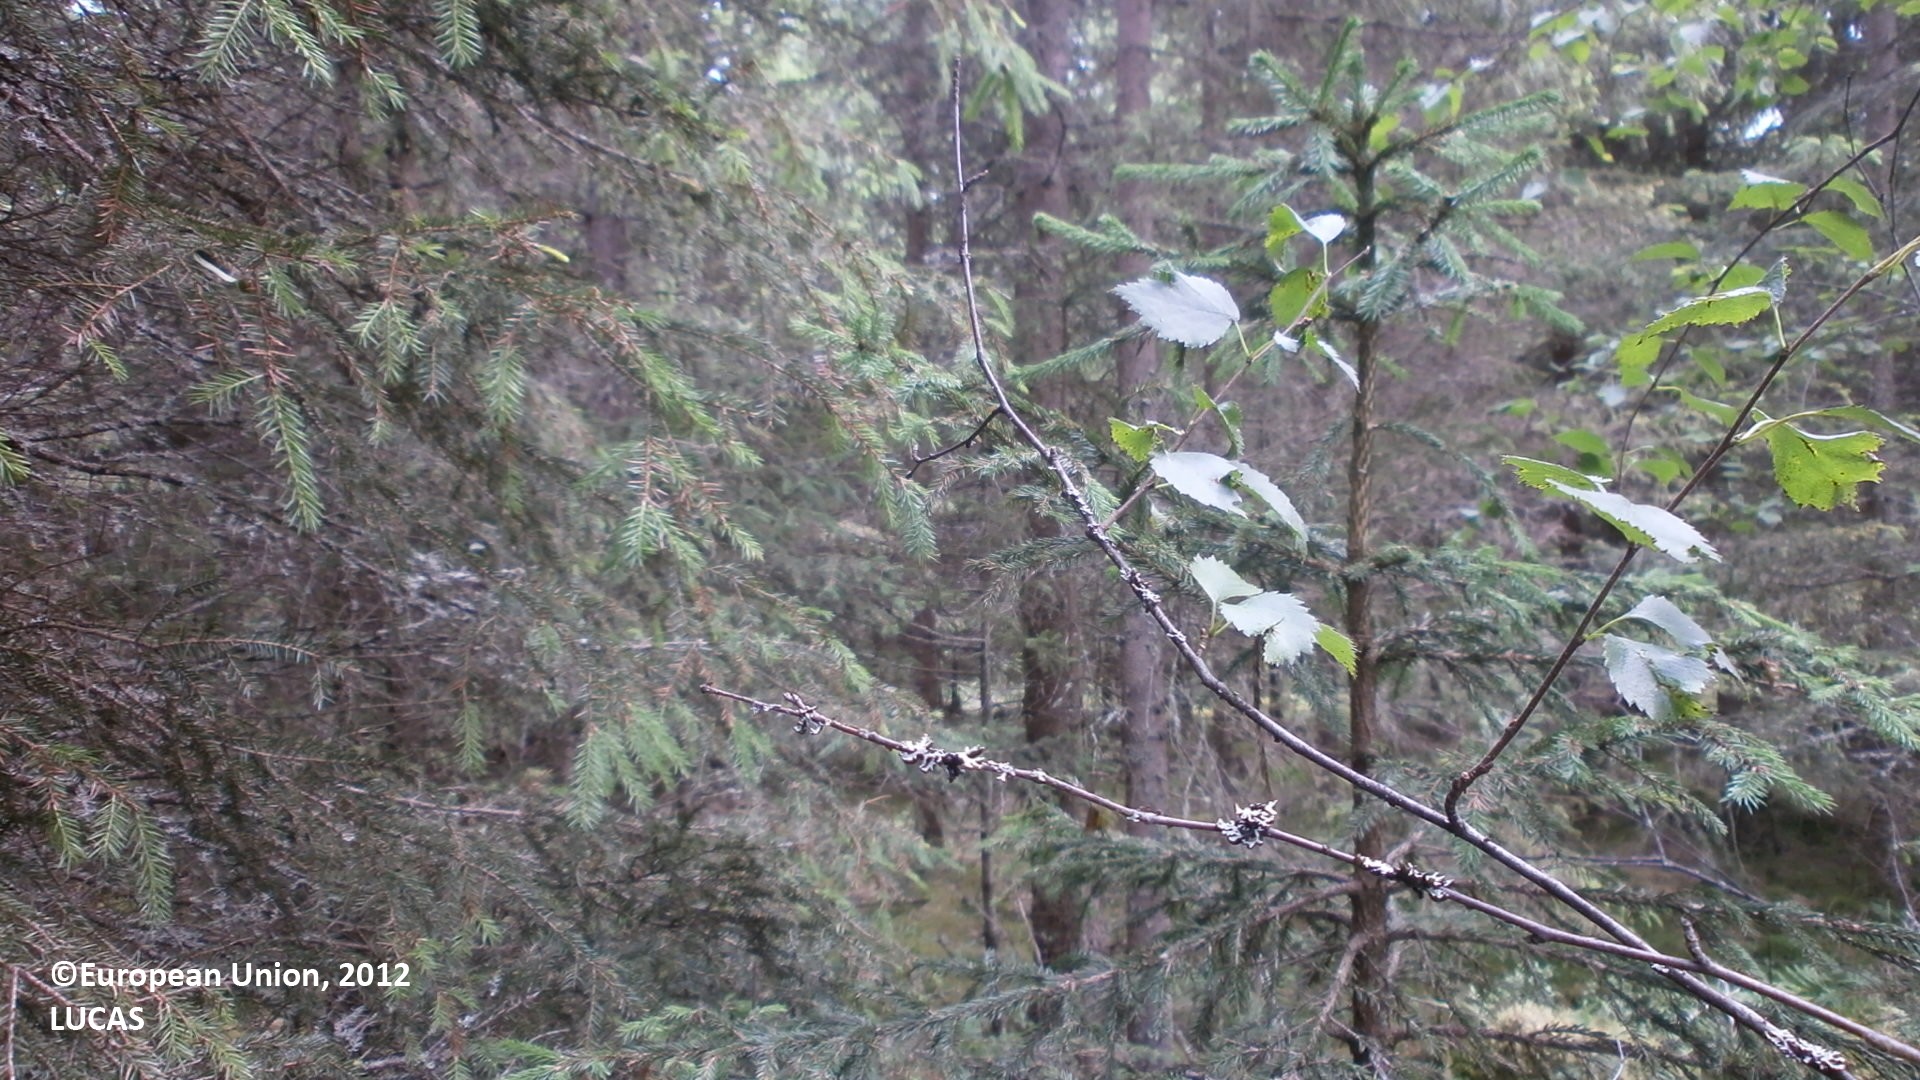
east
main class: Woodland
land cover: Spruce dominated coniferous woodland
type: boreal forest
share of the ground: > 75 %
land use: Forestry
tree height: > 5 m
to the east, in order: Spruce dominated coniferous woodland; Rivers and streams; Spruce dominated coniferous woodland; Tracks; Spruce dominated coniferous woodland; Tracks; Spruce dominated coniferous woodland; Tracks; Spruce dominated coniferous woodland; Ditches and canals; Spruce dominated mixed woodland; Tracks; Spruce dominated mixed woodland; Ditches and canals; Spruce dominated mixed woodland; Tracks; Ditches and canals; Spruce dominated mixed woodland; Ditches and canals; Spruce dominated mixed woodland
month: July
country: FI
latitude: 64.2342
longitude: 24.4001
